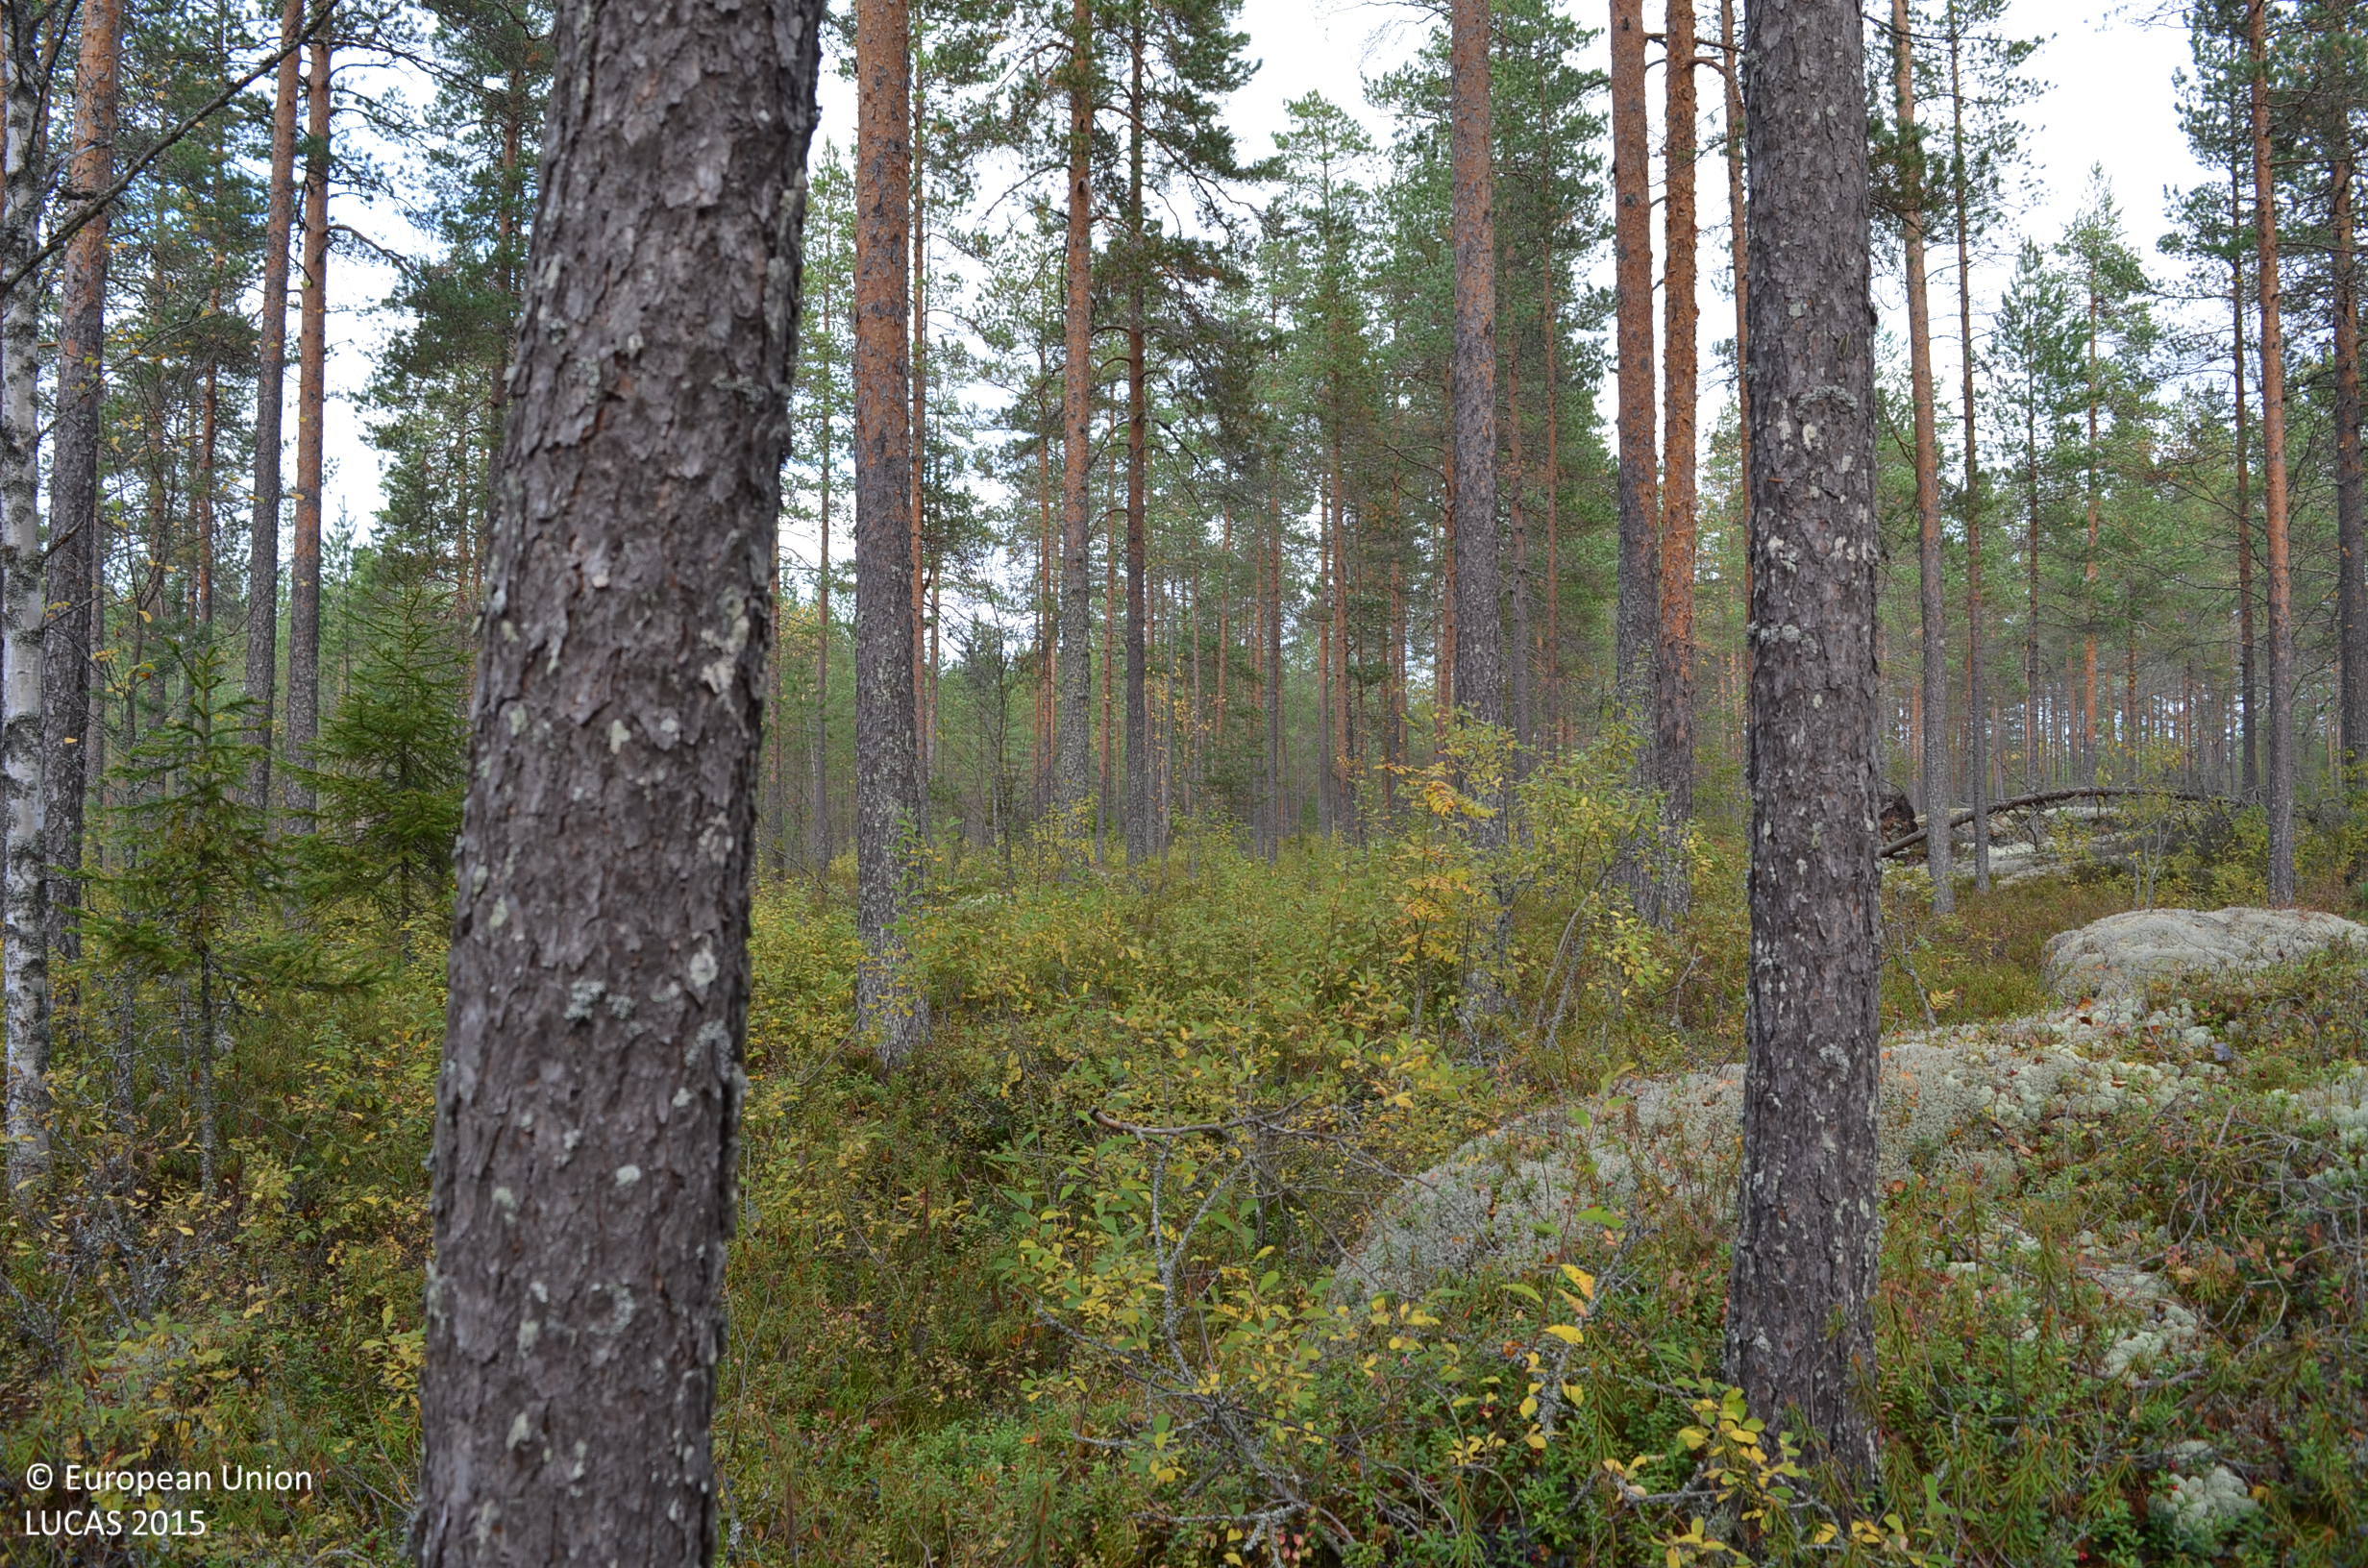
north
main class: Woodland
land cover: Pine dominated coniferous woodland
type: boreal forest
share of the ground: 50 - 75 %
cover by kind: coniferous forest trees 55 %, shrubs 25 %, unconsolidated bare surface 15 %, broadleaved forest trees 5 %
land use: Forestry
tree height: > 5 m
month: September
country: FI
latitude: 62.5259
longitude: 23.5756
